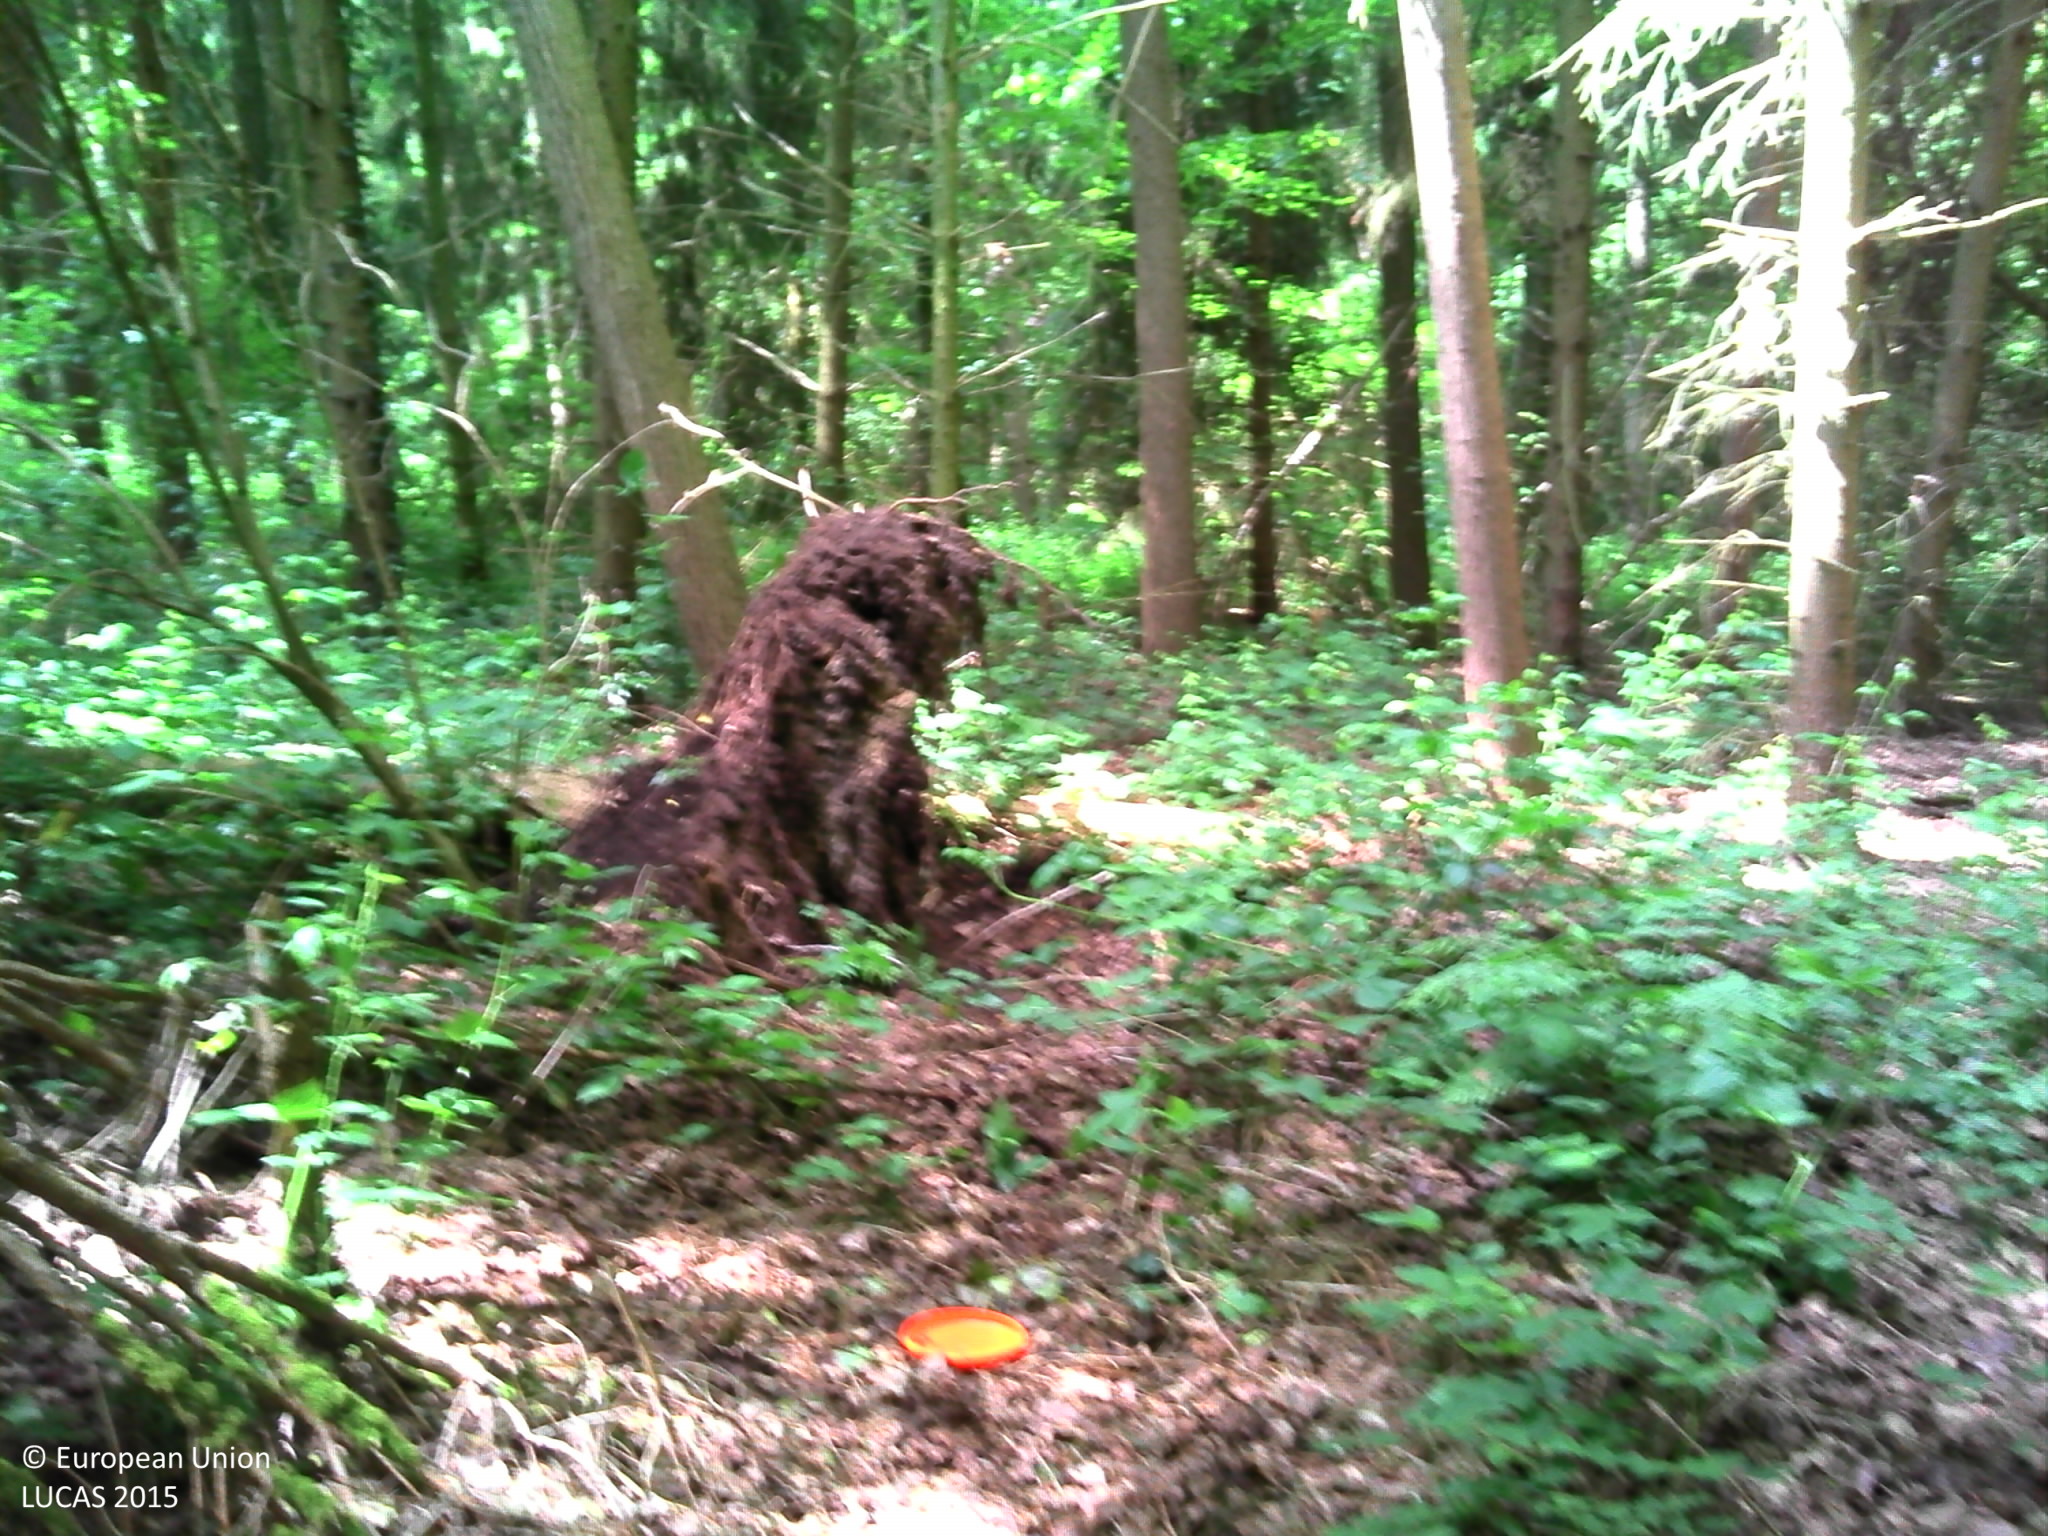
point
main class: Woodland
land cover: Spruce dominated coniferous woodland
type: hemiboreal forest and nemoral coniferous forest and mixed broadleaved-coniferous forest
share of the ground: > 75 %
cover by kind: coniferous forest trees 100 %
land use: Forestry
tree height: > 5 m
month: June
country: BE
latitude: 50.9400
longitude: 3.8885
